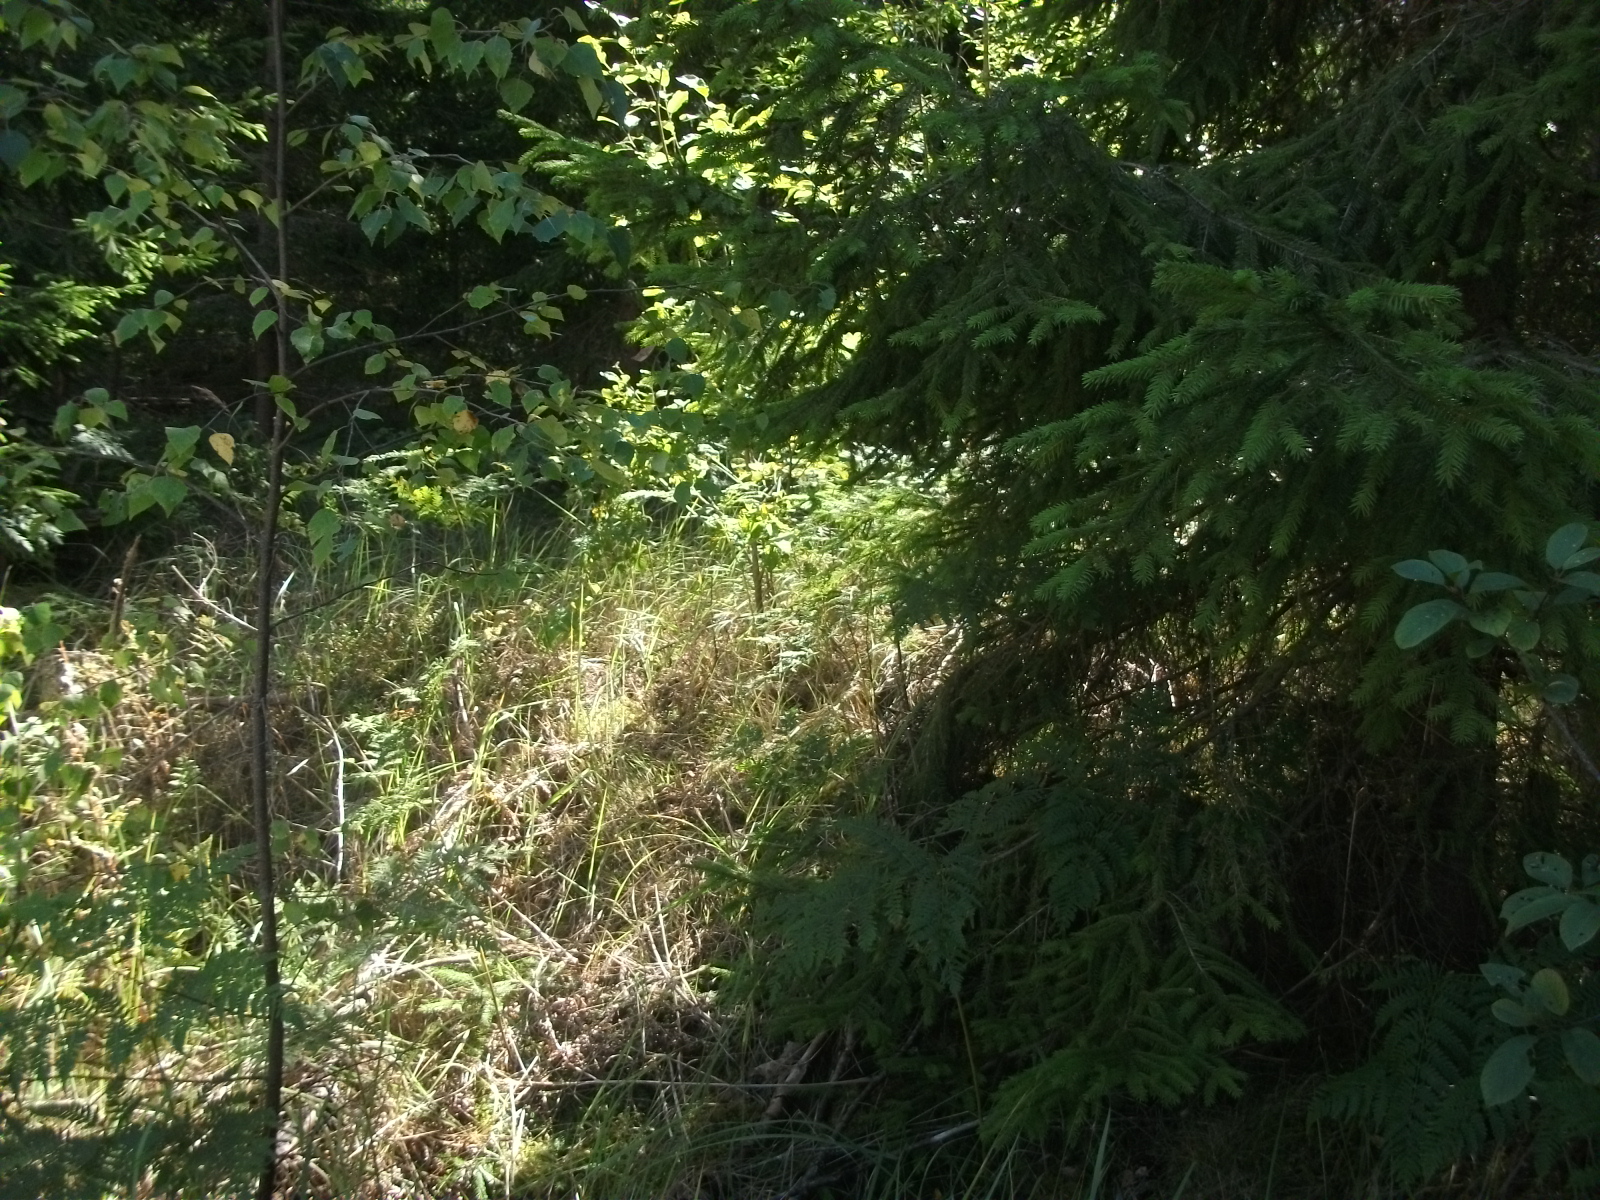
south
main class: Woodland
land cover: Other coniferous woodland
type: hemiboreal forest and nemoral coniferous forest and mixed broadleaved-coniferous forest
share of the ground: > 75 %
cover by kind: coniferous forest trees 80 %, herbaceous plants 10 %, shrubs 5 %, lichens and mosses 5 %
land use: Forestry
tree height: > 5 m
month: August
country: LV
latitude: 56.6109
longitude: 26.1197
